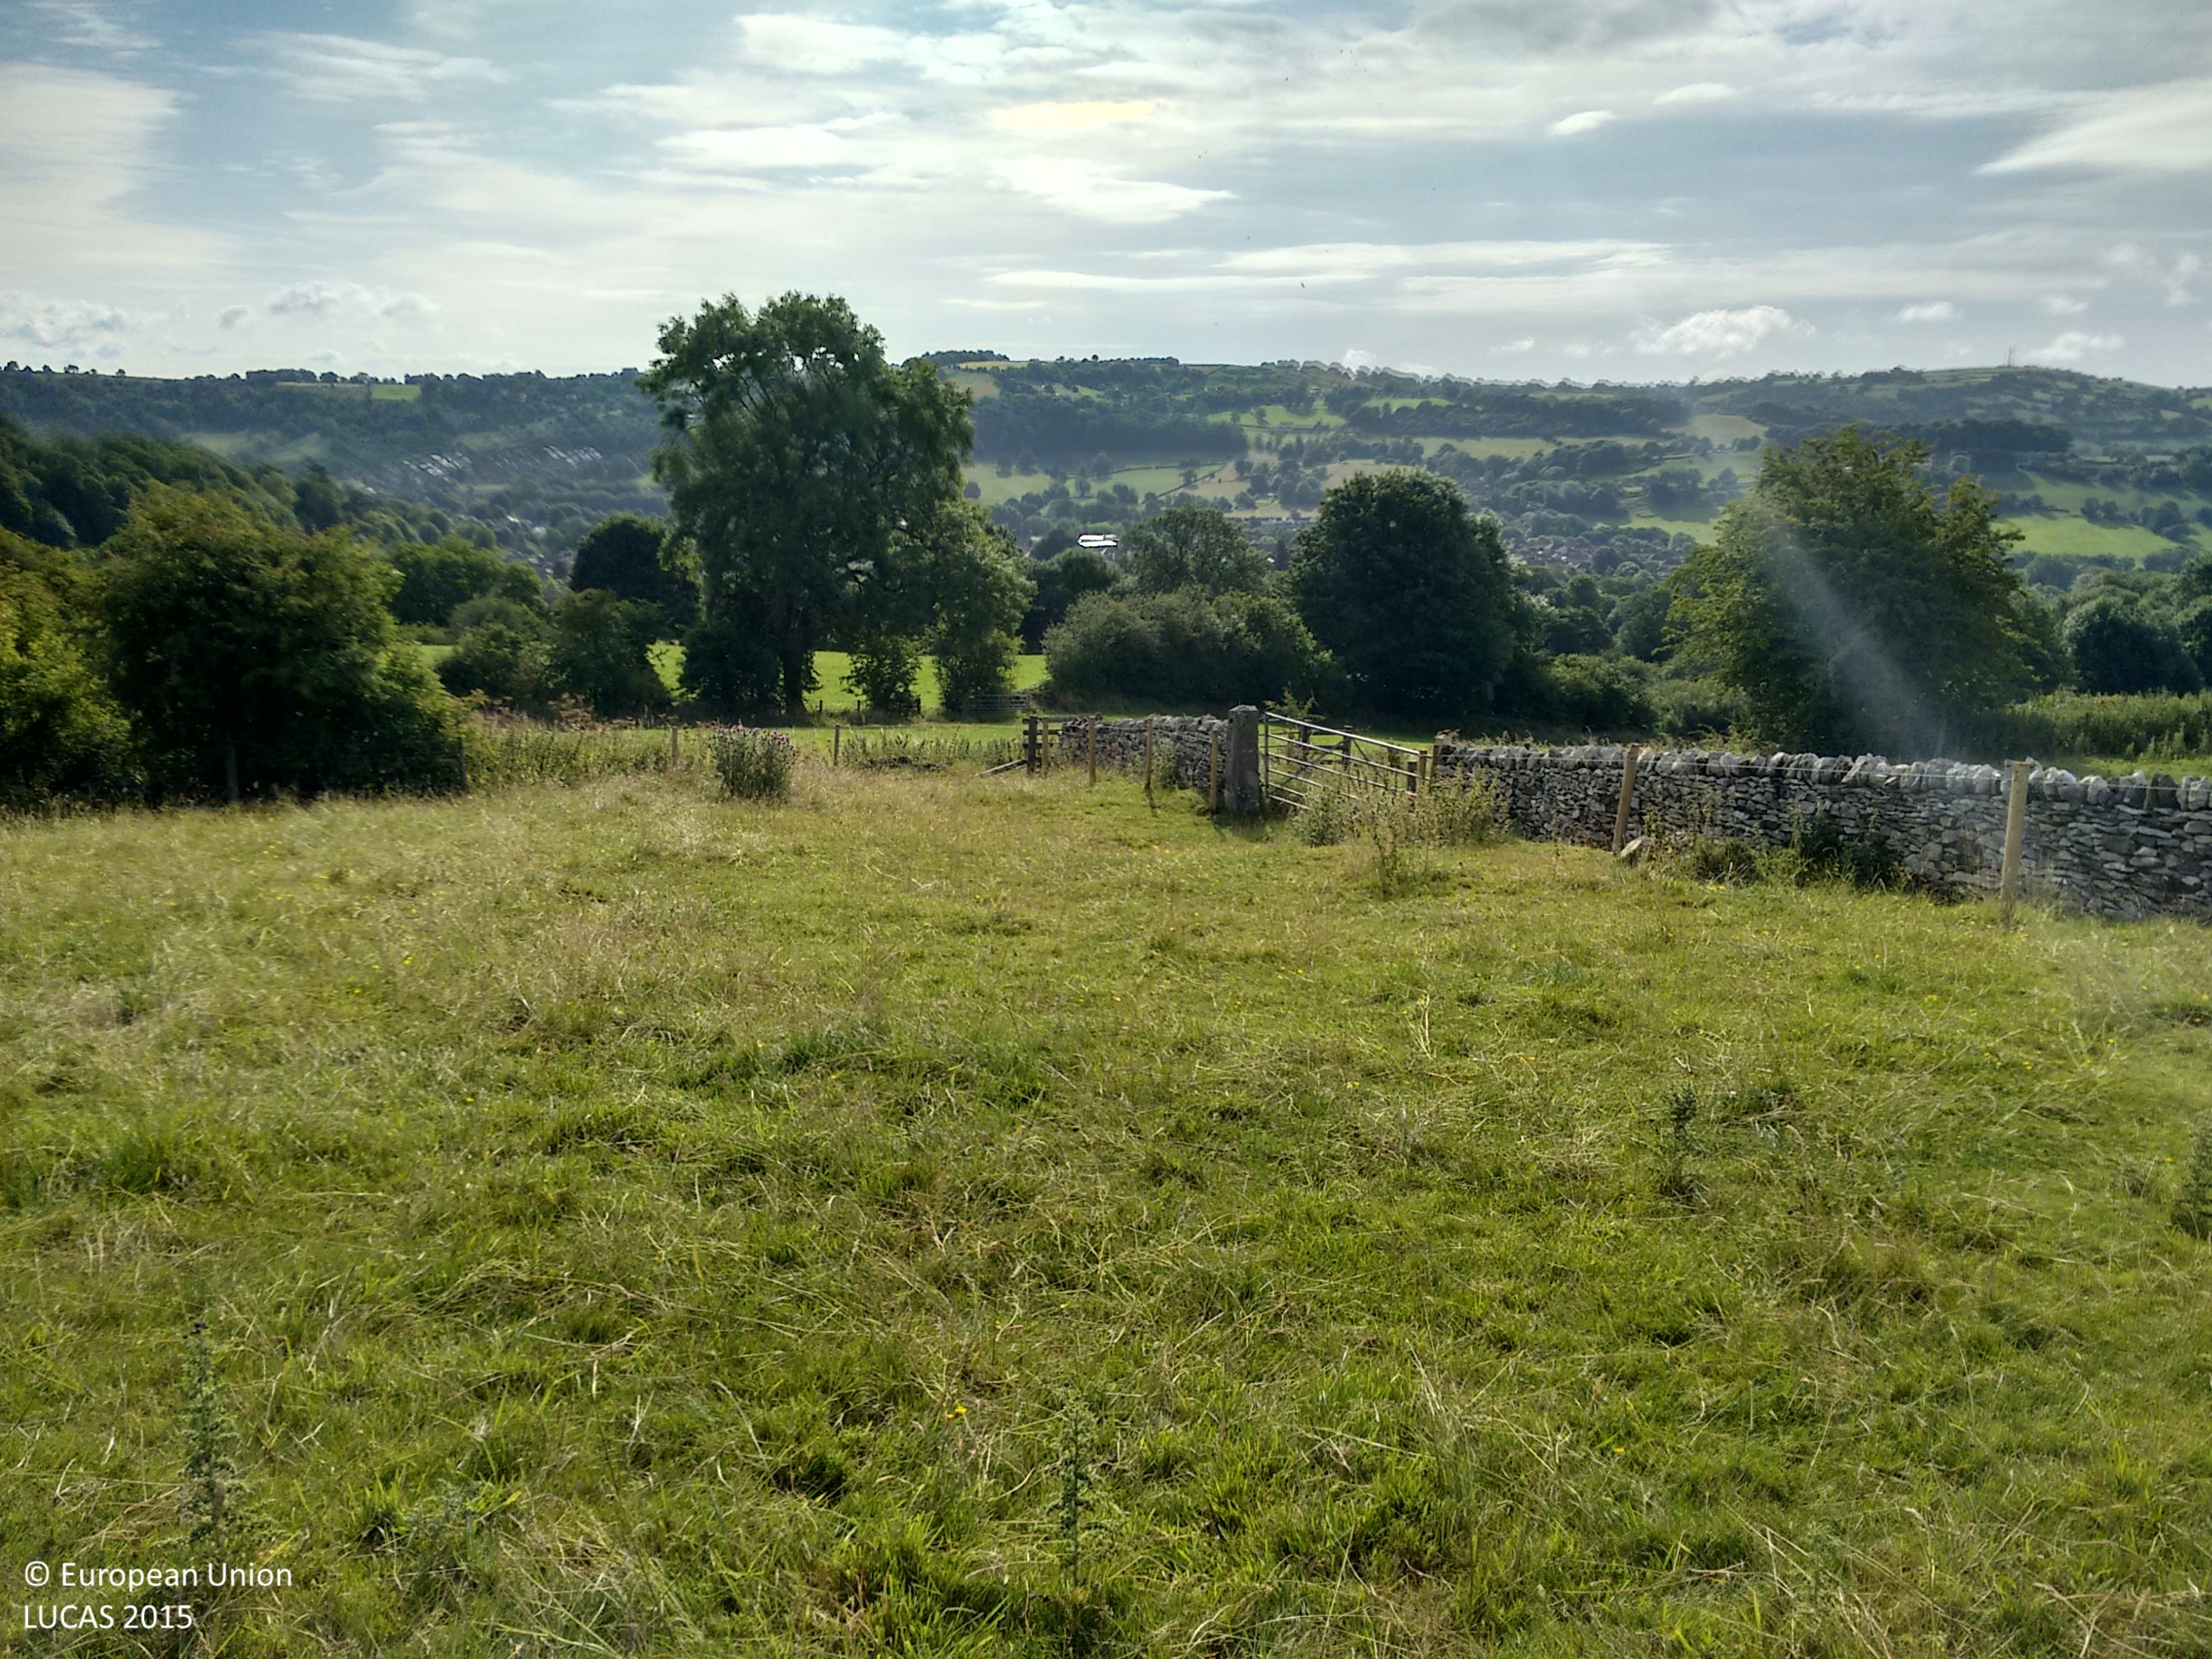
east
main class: Grassland
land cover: Grassland without tree/shrub cover
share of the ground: > 75 %
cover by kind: herbaceous plants 100 %
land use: Agriculture (excluding fallow land and kitchen gardens)
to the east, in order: Grassland without tree/shrub cover; Fences; Dry stone walls; Managed hedges; Grassland without tree/shrub cover; Fences; Abandoned hedges; Grassland without tree/shrub cover; Abandoned hedges; Grassland without tree/shrub cover
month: July
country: GB
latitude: 53.0793
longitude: -1.5911
